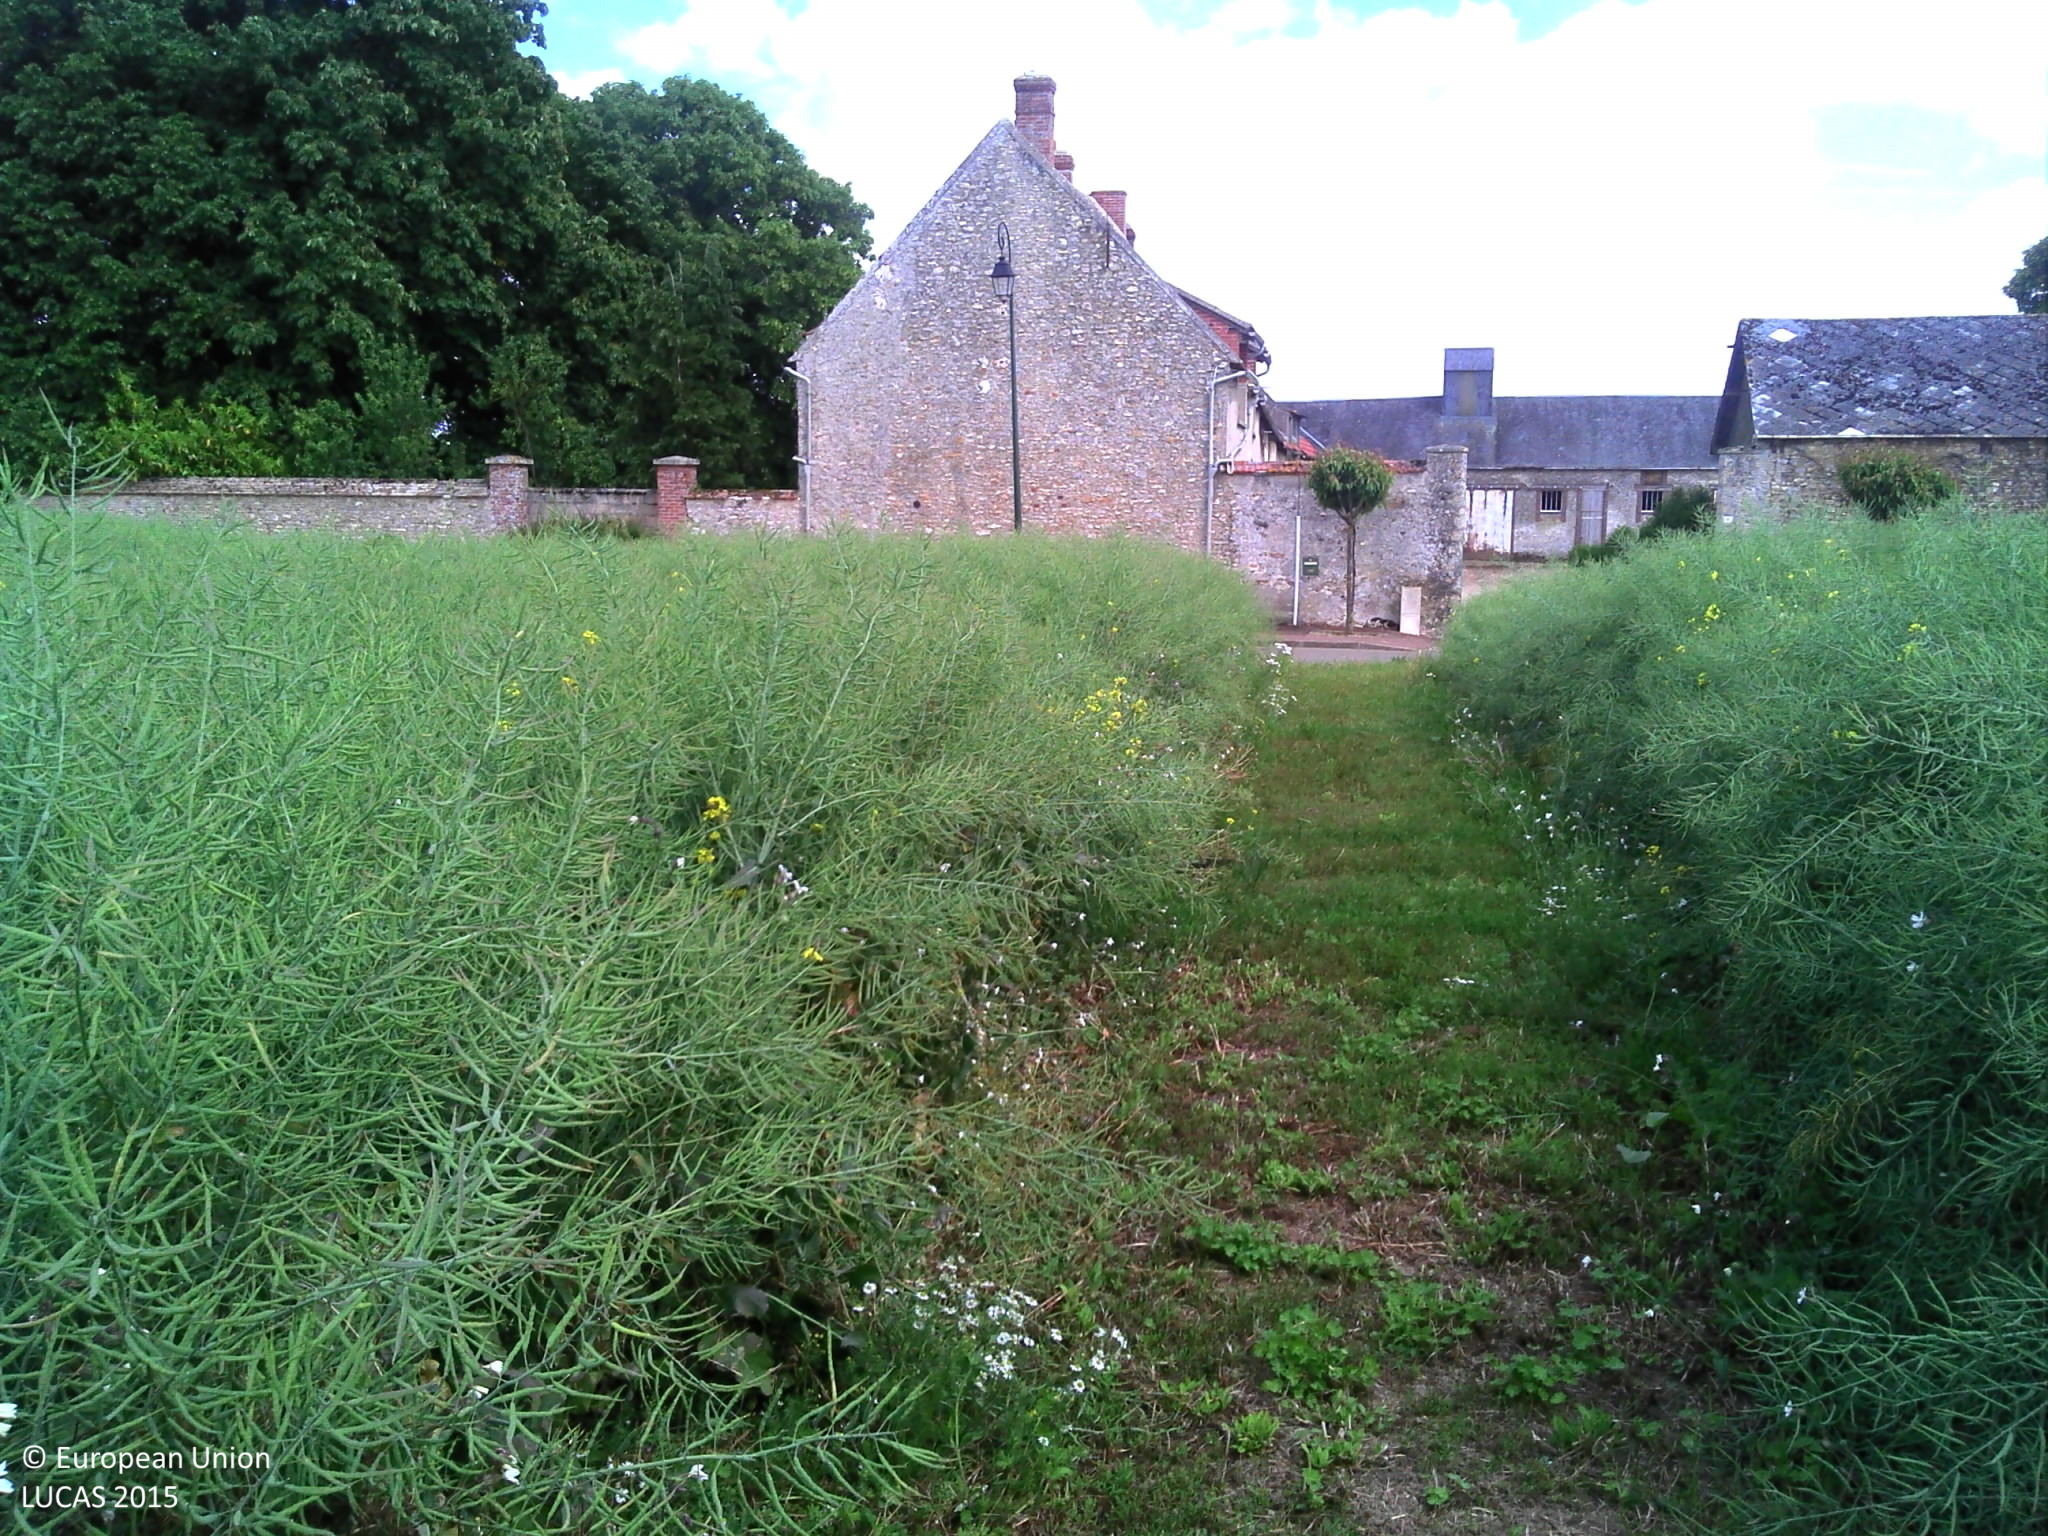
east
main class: Cropland
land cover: Rape and turnip rape
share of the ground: > 75 %
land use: Agriculture (excluding fallow land and kitchen gardens)
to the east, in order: Rape and turnip rape; Artificial constructions in urban areas; Maize
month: June
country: FR
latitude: 48.4308
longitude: 1.8903
